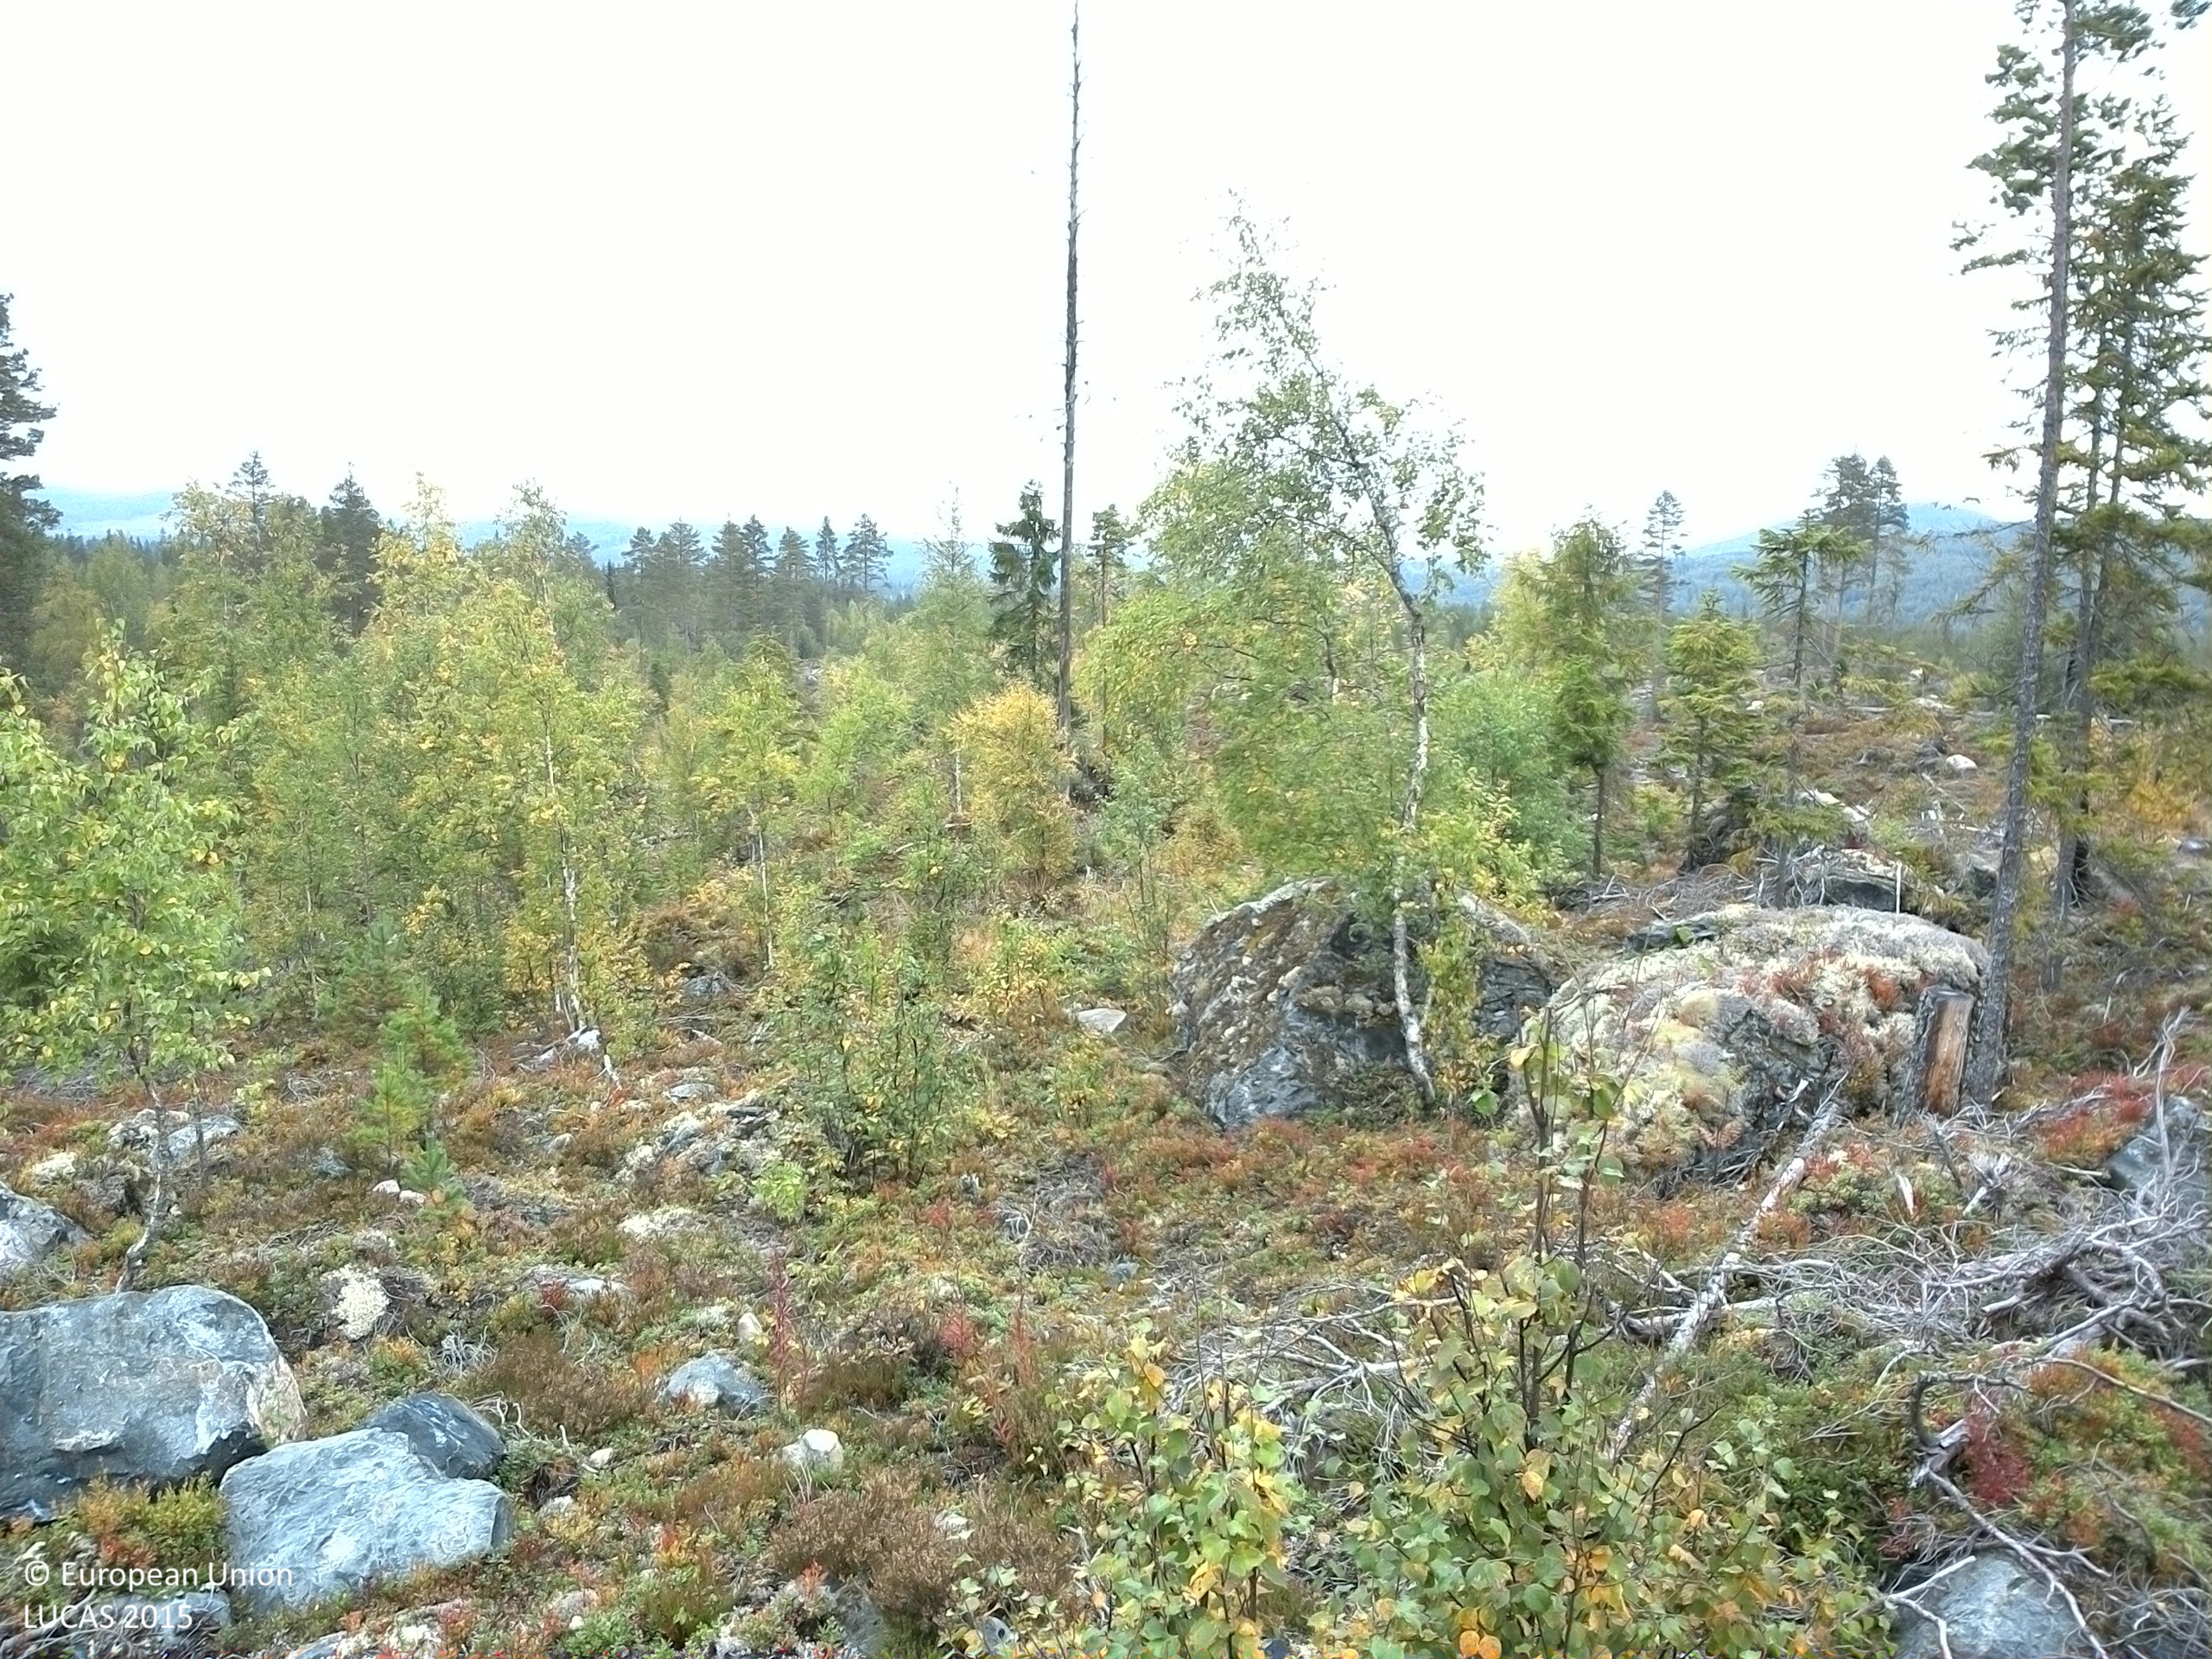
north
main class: Woodland
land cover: Other mixed woodland
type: boreal forest
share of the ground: 10 - 25 %
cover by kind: shrubs 45 %, lichens and mosses 20 %, consolidated bare surface 20 %, broadleaved forest trees 10 %, coniferous forest trees 5 %
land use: Forestry
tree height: < 5 m
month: September
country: SE
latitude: 61.6037
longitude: 15.1297
